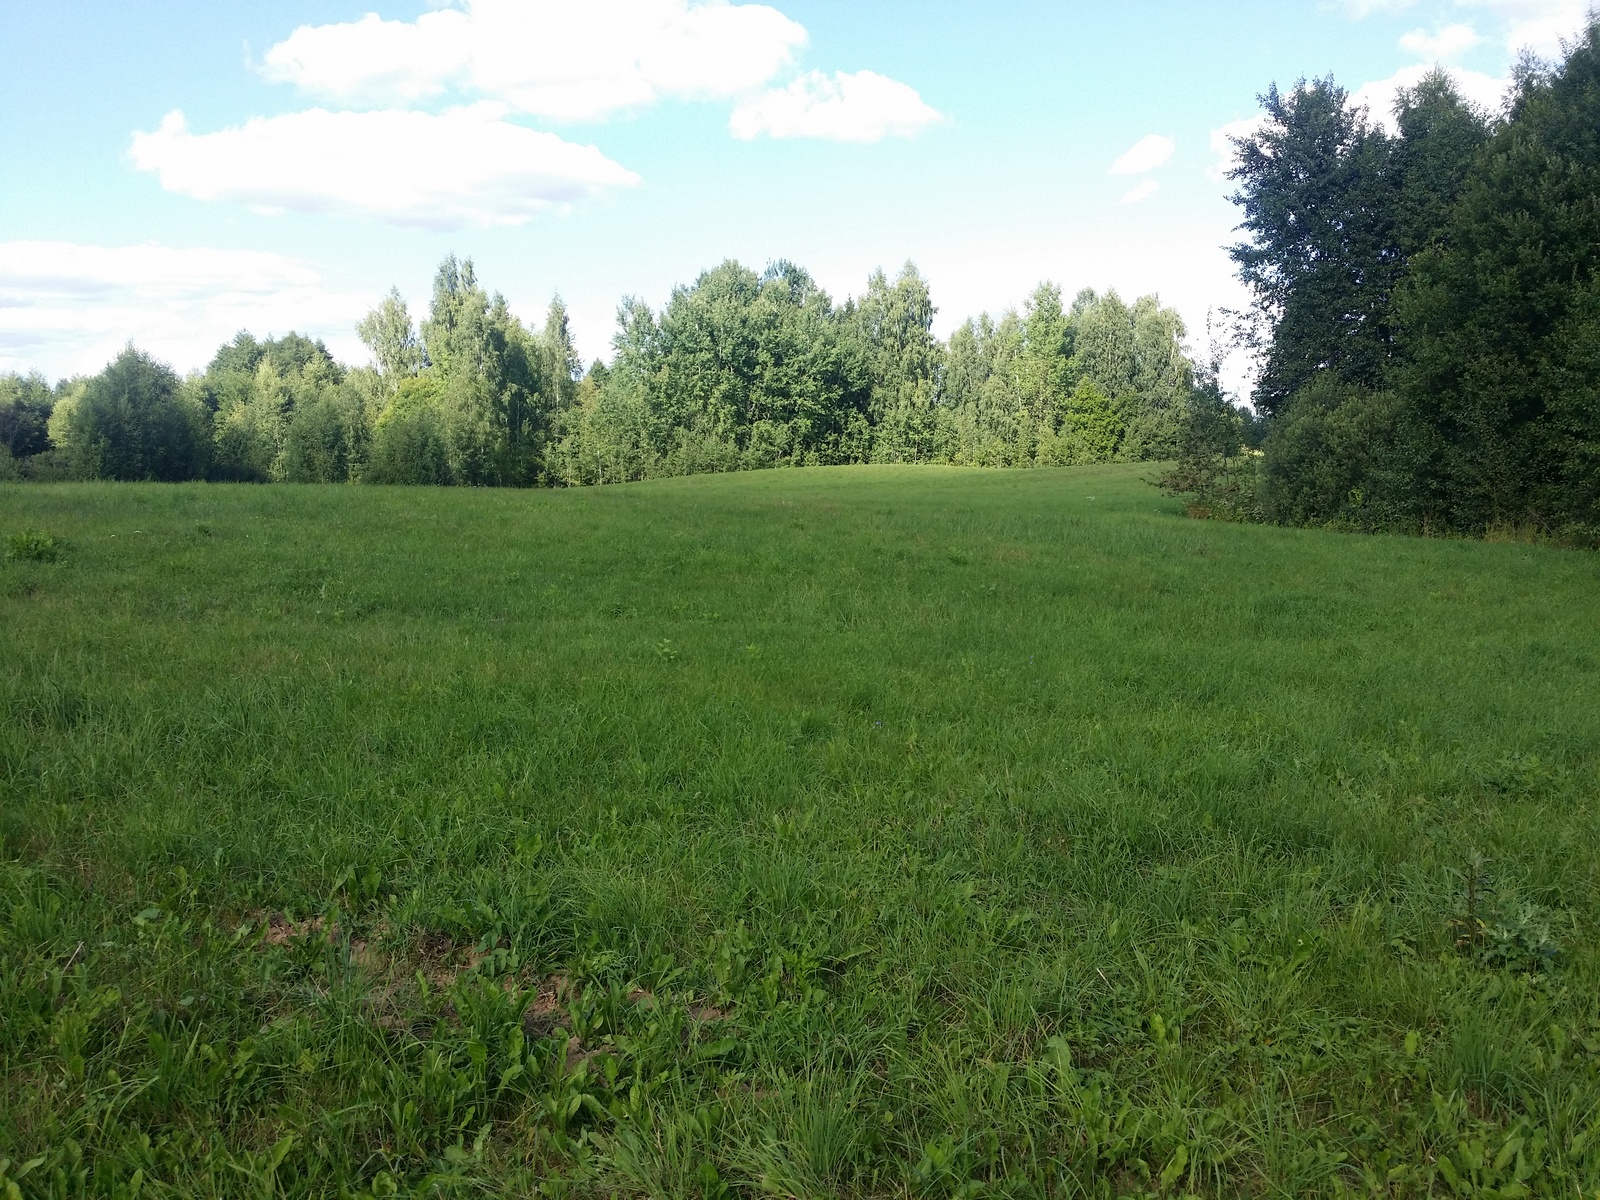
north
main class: Grassland
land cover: Grassland without tree/shrub cover
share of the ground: > 75 %
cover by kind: herbaceous plants 100 %
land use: Agriculture (excluding fallow land and kitchen gardens)
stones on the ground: < 10 %
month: August
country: LV
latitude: 56.9692
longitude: 27.5998
